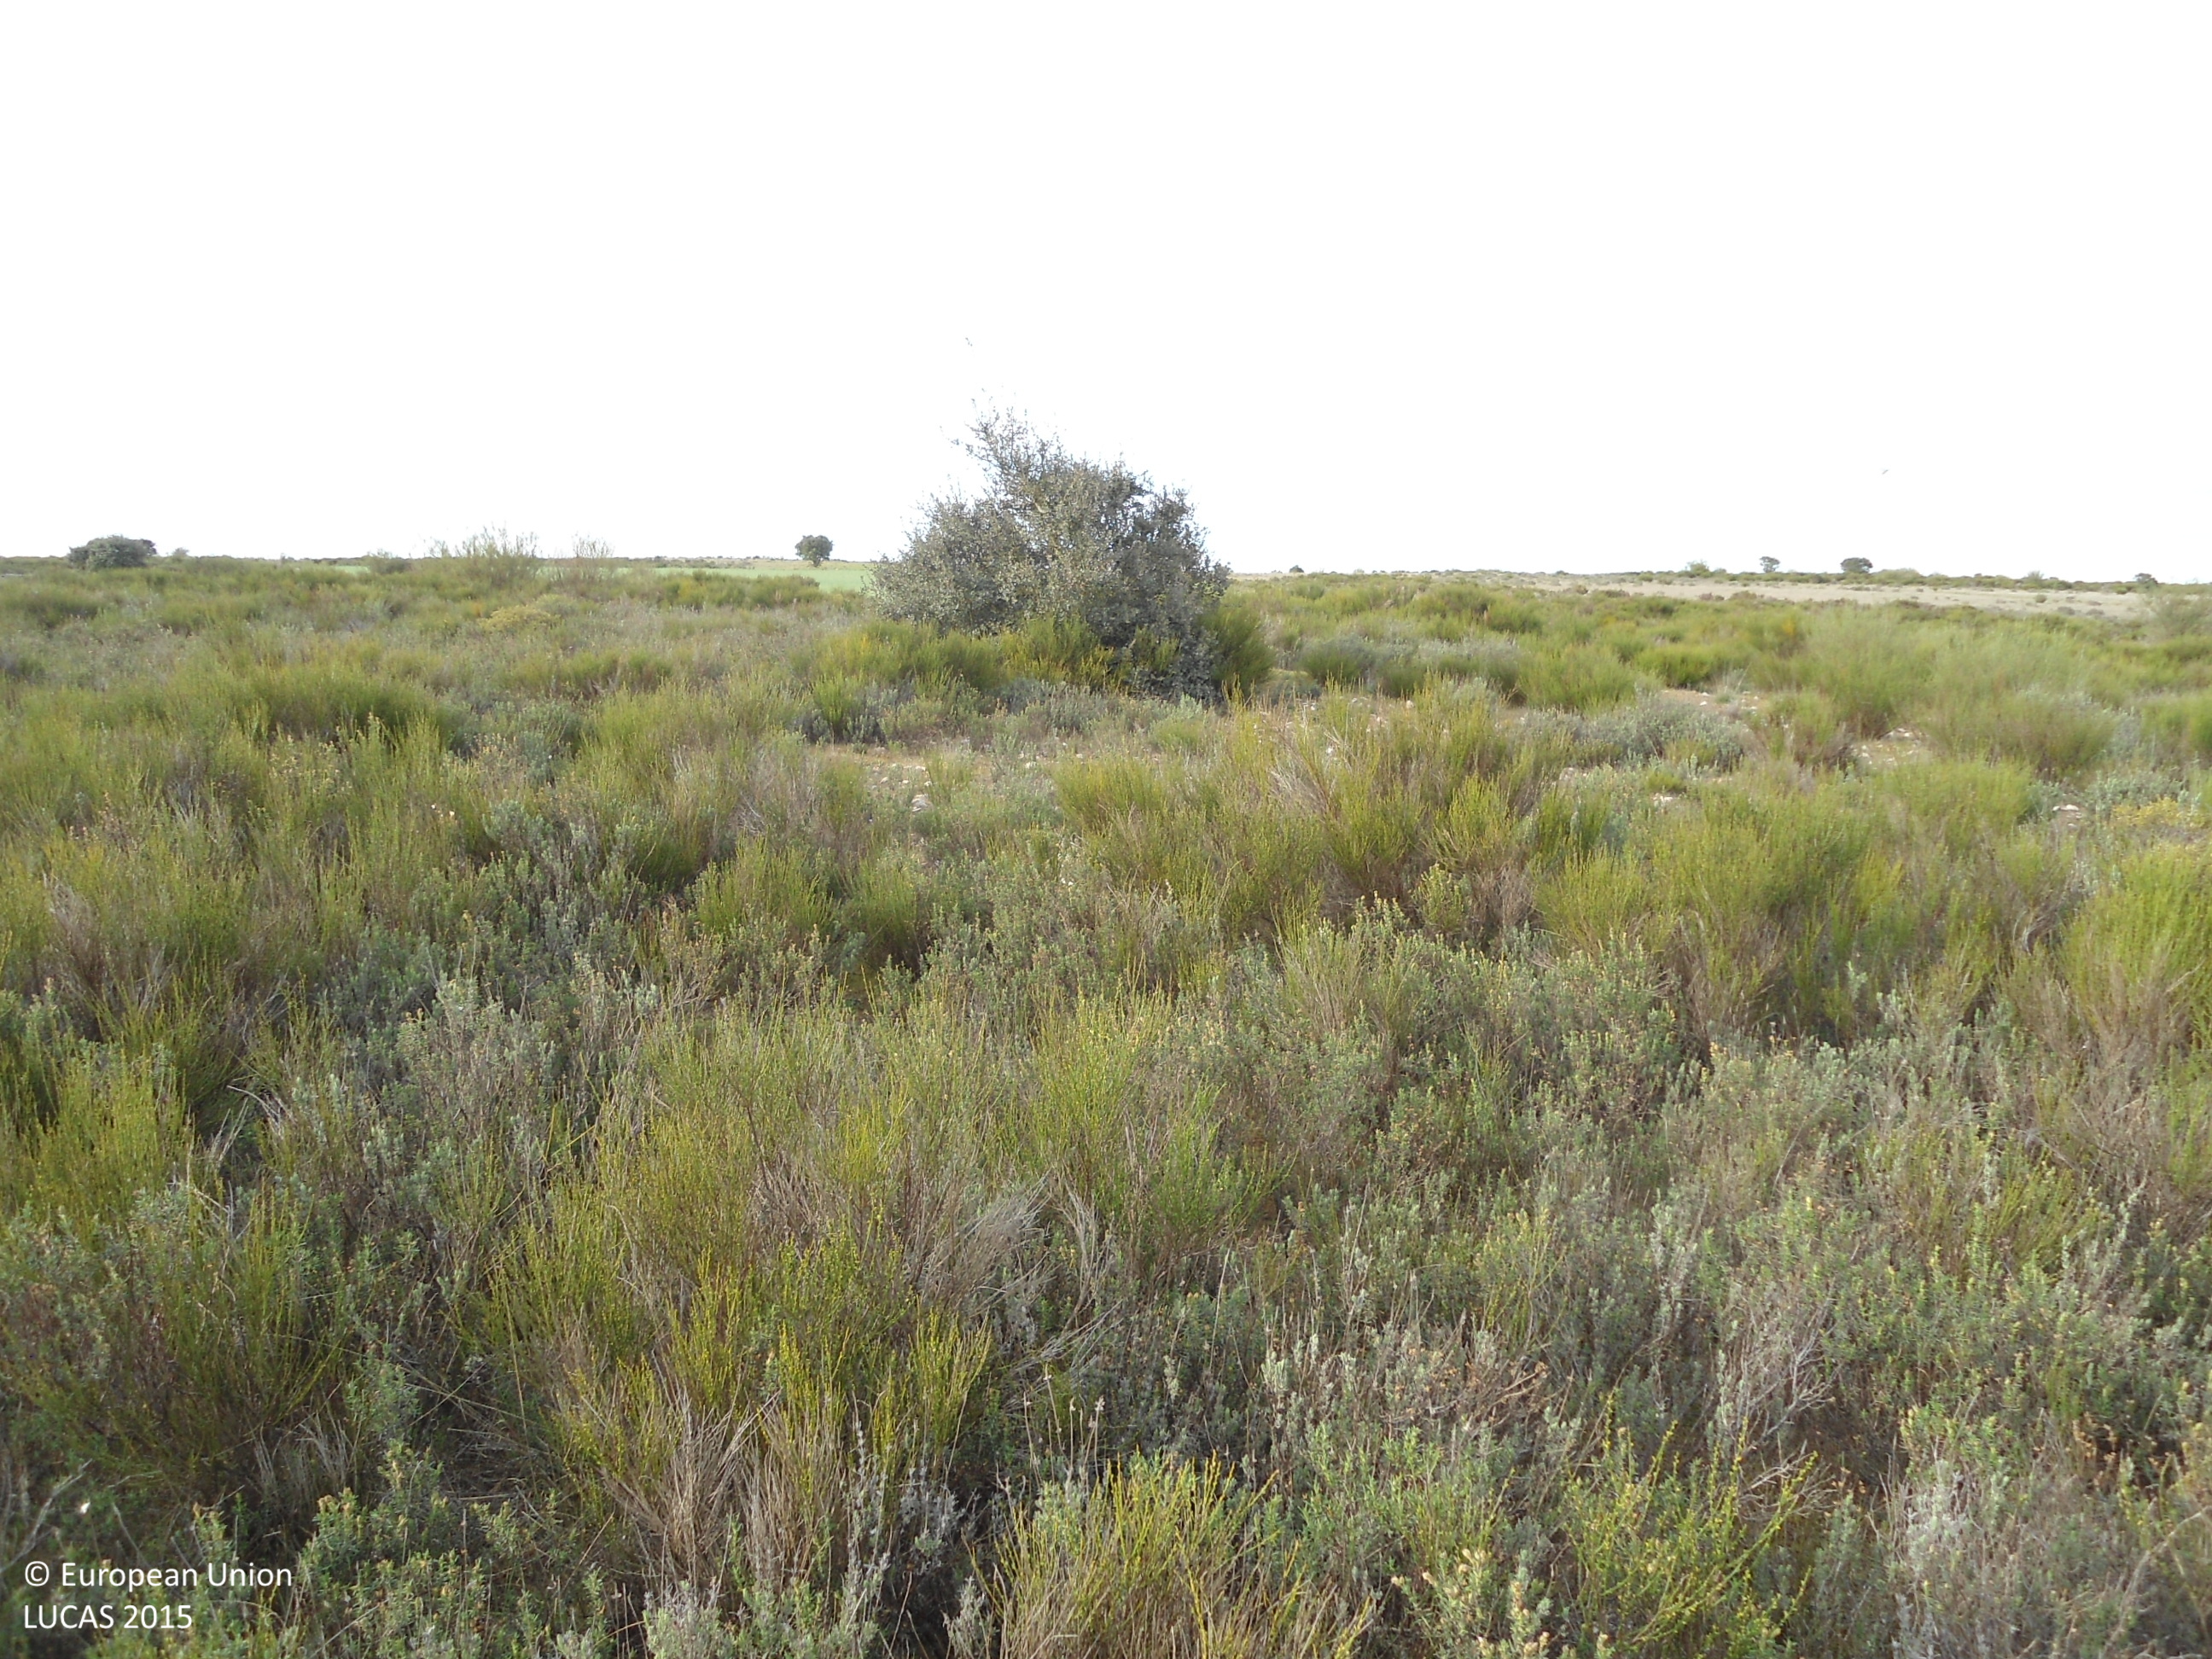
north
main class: Shrubland
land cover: Shrubland without tree cover
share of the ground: > 75 %
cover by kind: shrubs 90 %, herbaceous plants 10 %
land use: Fallow land
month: April
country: ES
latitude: 41.5795
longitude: -6.0828
